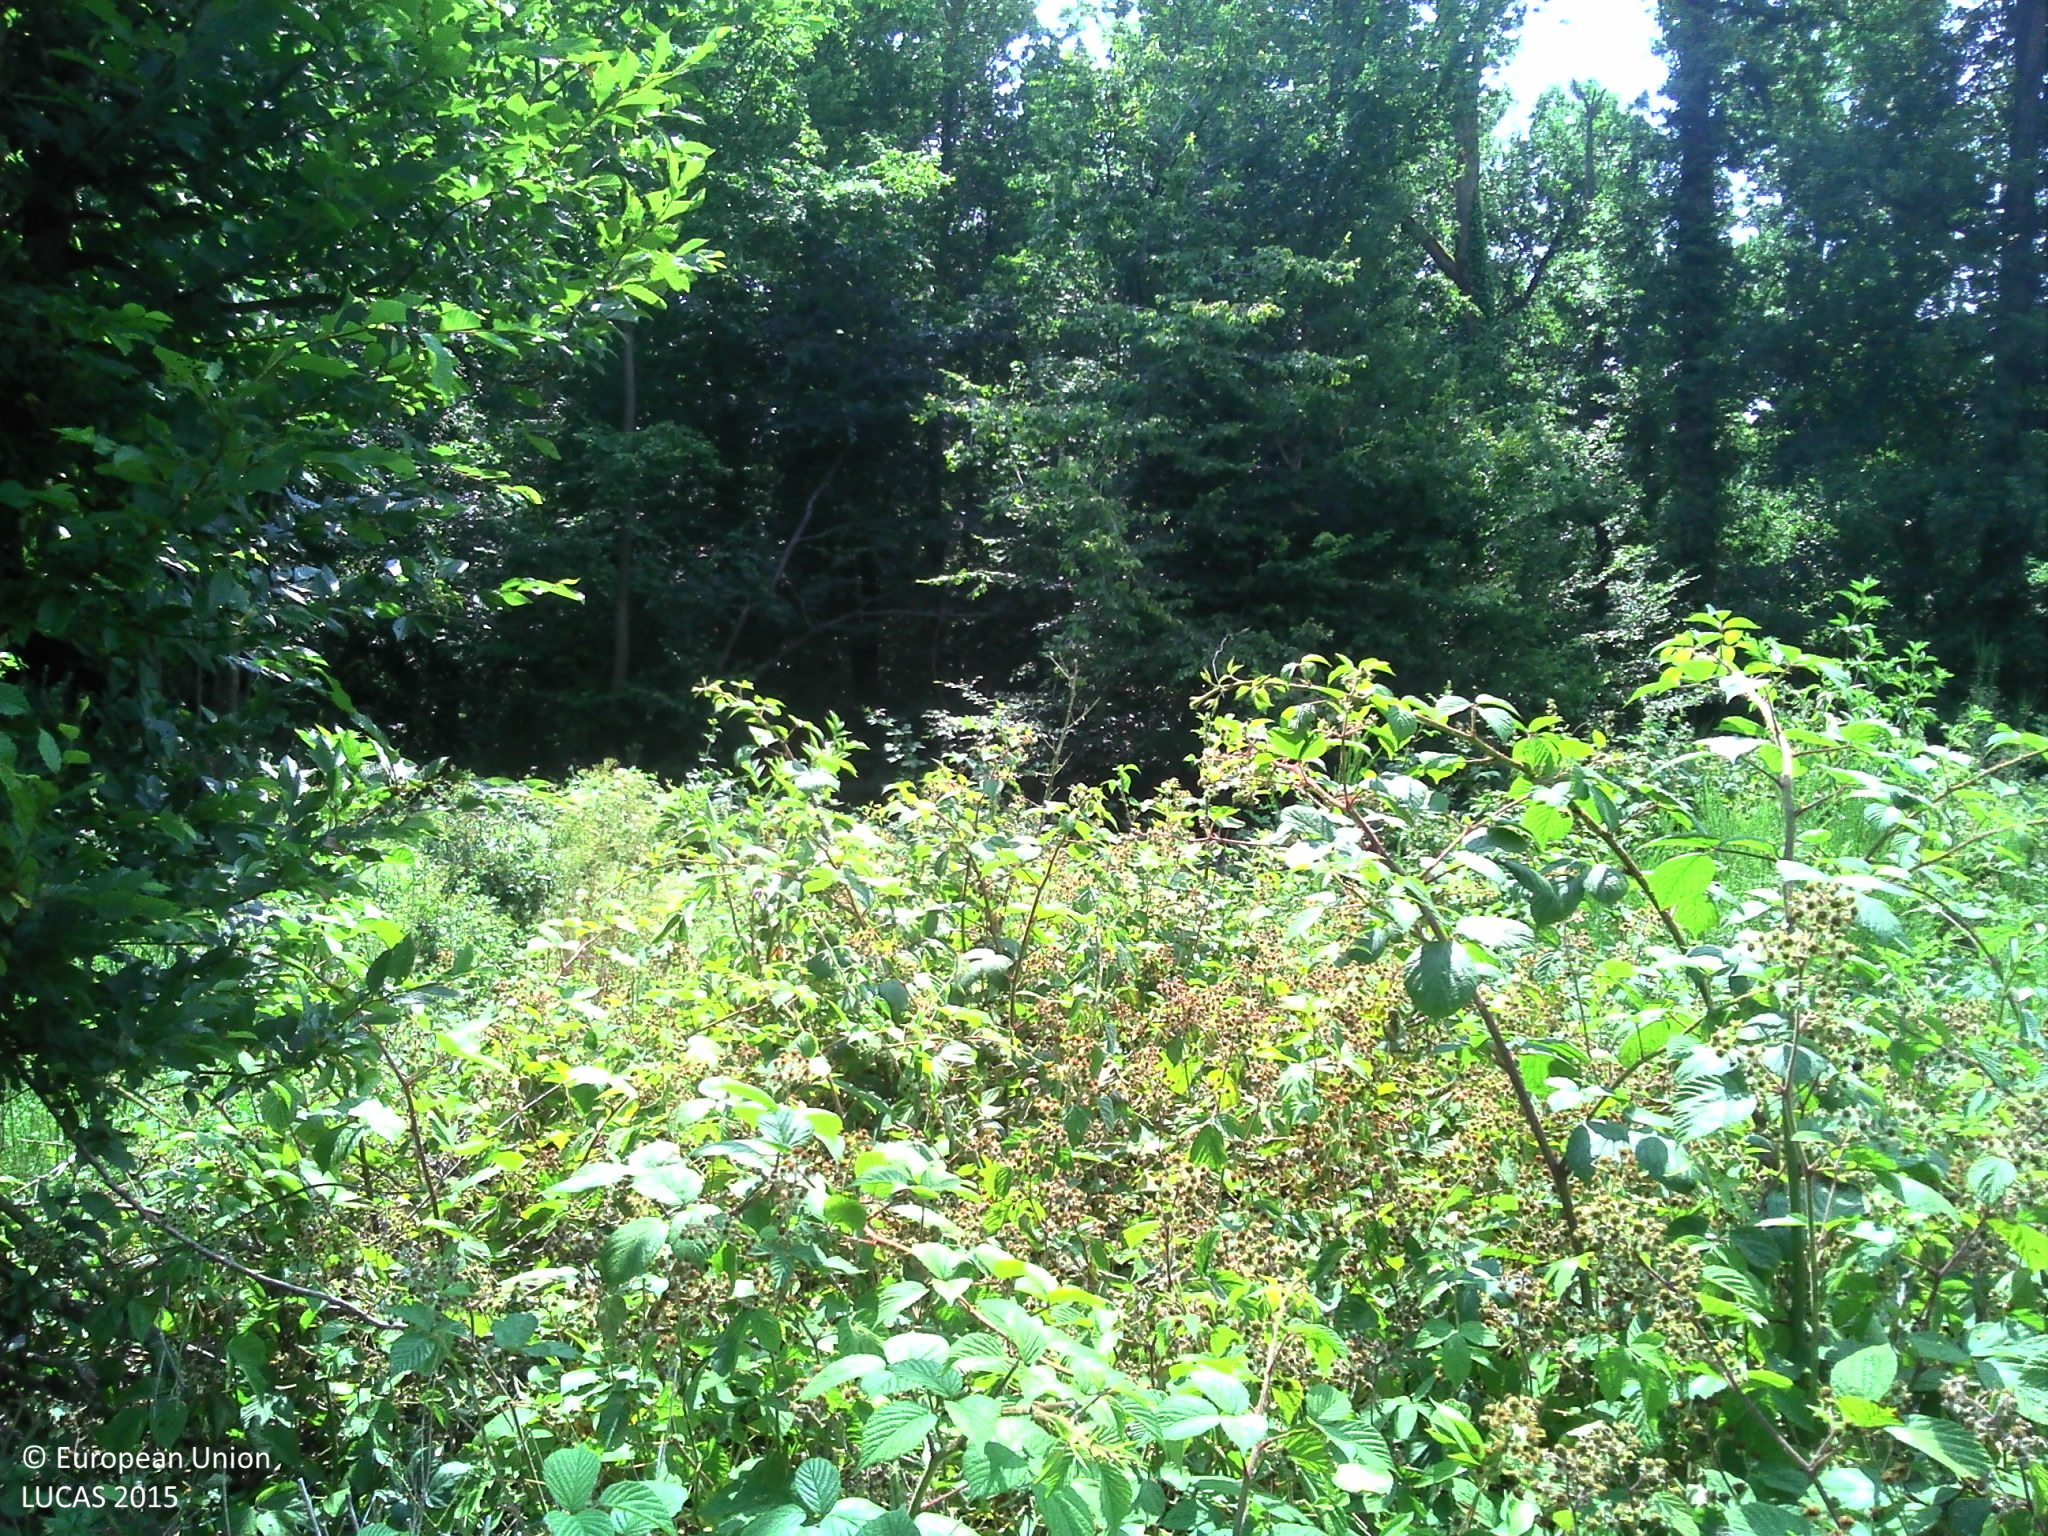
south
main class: Shrubland
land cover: Shrubland without tree cover
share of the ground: > 75 %
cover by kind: herbaceous plants 60 %, shrubs 40 %
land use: Forestry
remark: Clear cut
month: July
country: FR
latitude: 48.8119
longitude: 1.1970
